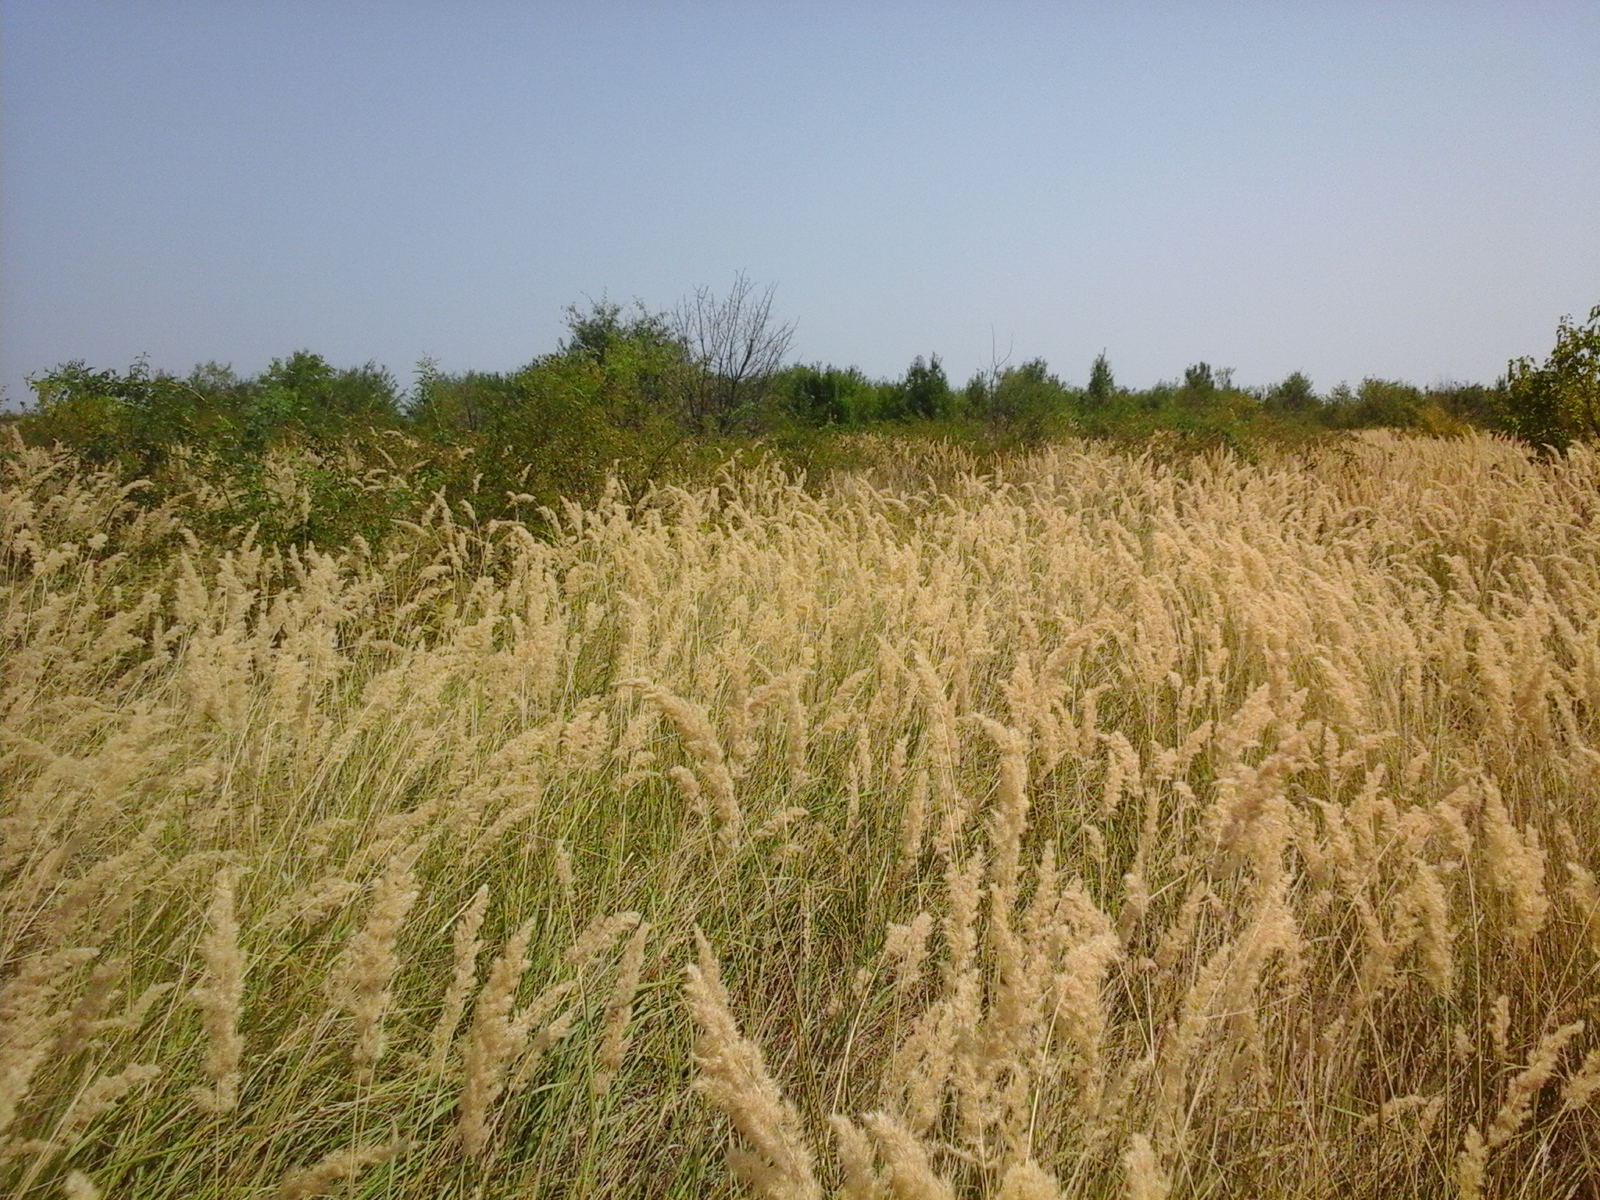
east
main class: Grassland
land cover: Grassland with sparse tree/shrub cover
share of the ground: > 75 %
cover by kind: herbaceous plants 85 %, shrubs 10 %, broadleaved forest trees 5 %
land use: Fallow land
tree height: < 5 m
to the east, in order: Grassland with sparse tree/shrub cover; Shrubland with sparse tree cover; Common wheat
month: August
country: RO
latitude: 44.4699
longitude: 22.6229
